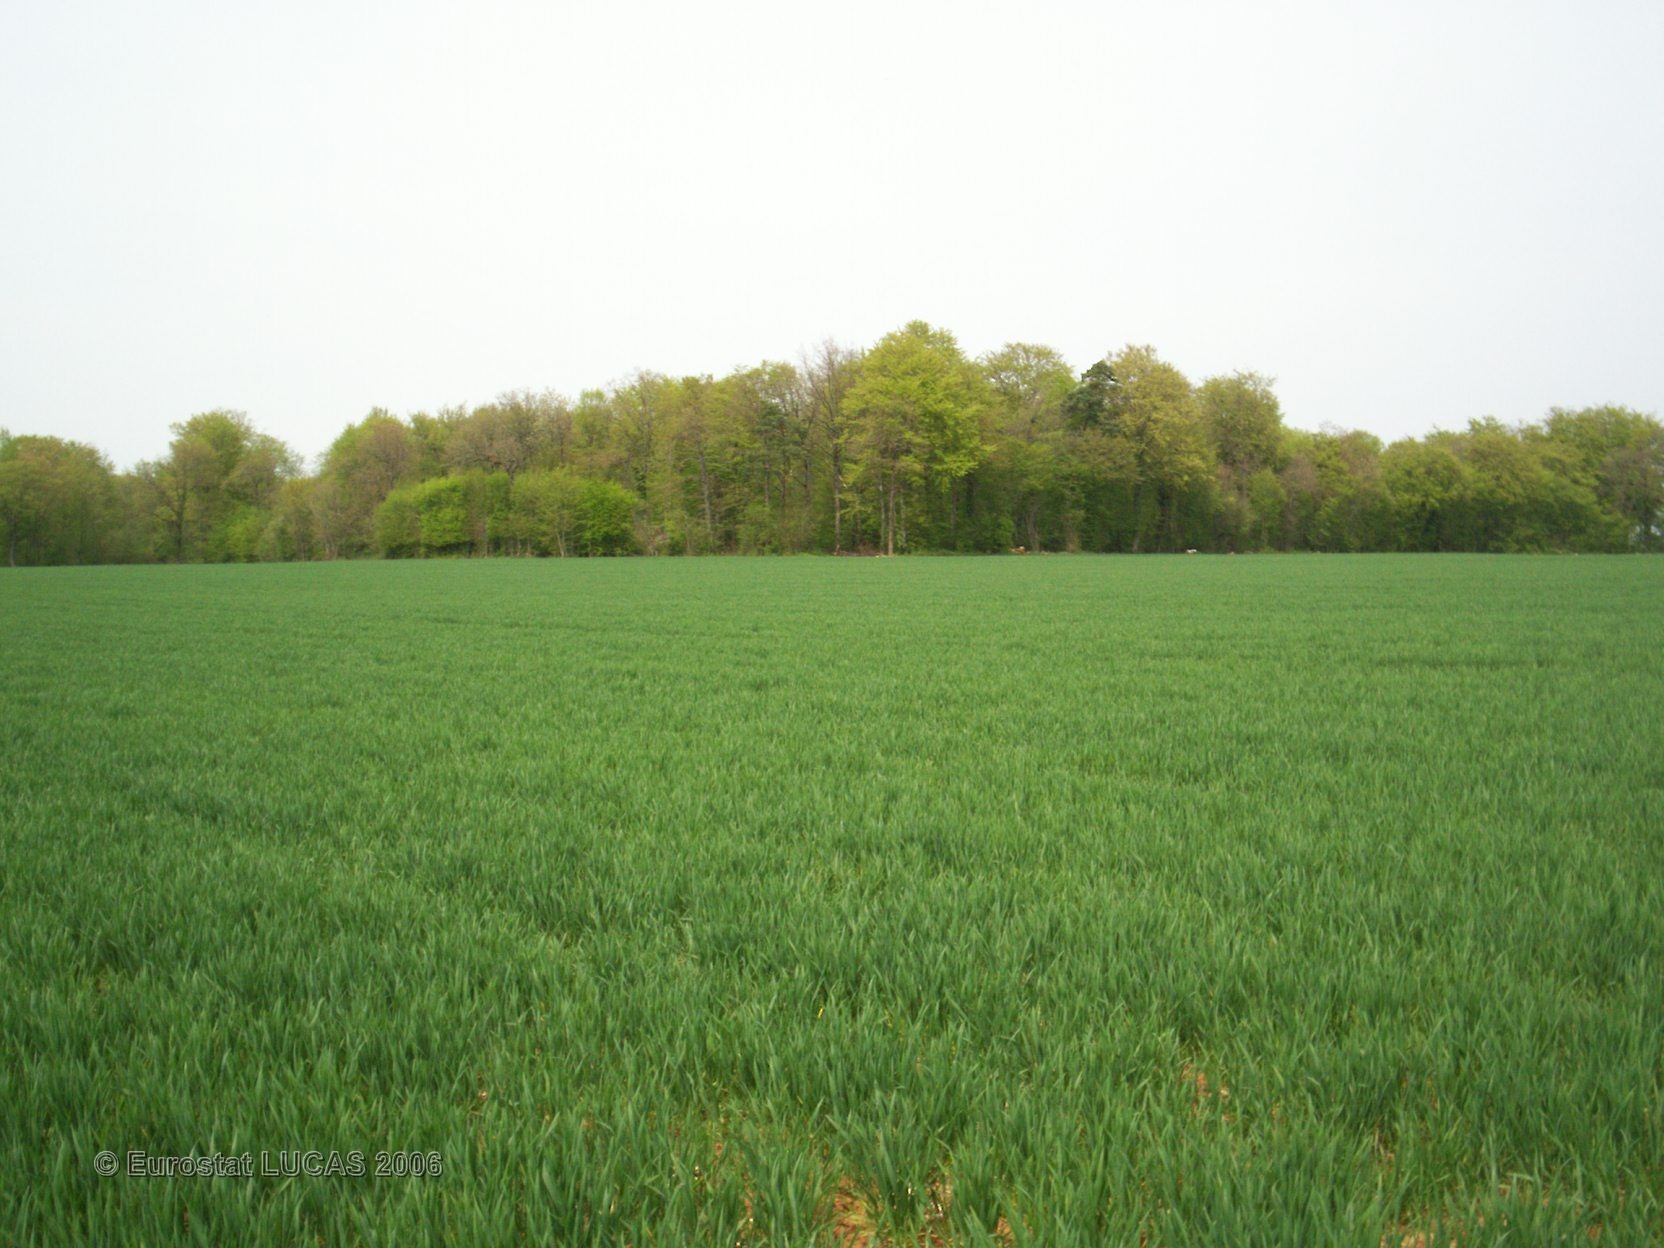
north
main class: Cropland
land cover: Common wheat
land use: Agriculture (excluding fallow land and kitchen gardens)
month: May
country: FR
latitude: 47.6932
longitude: 4.5760
